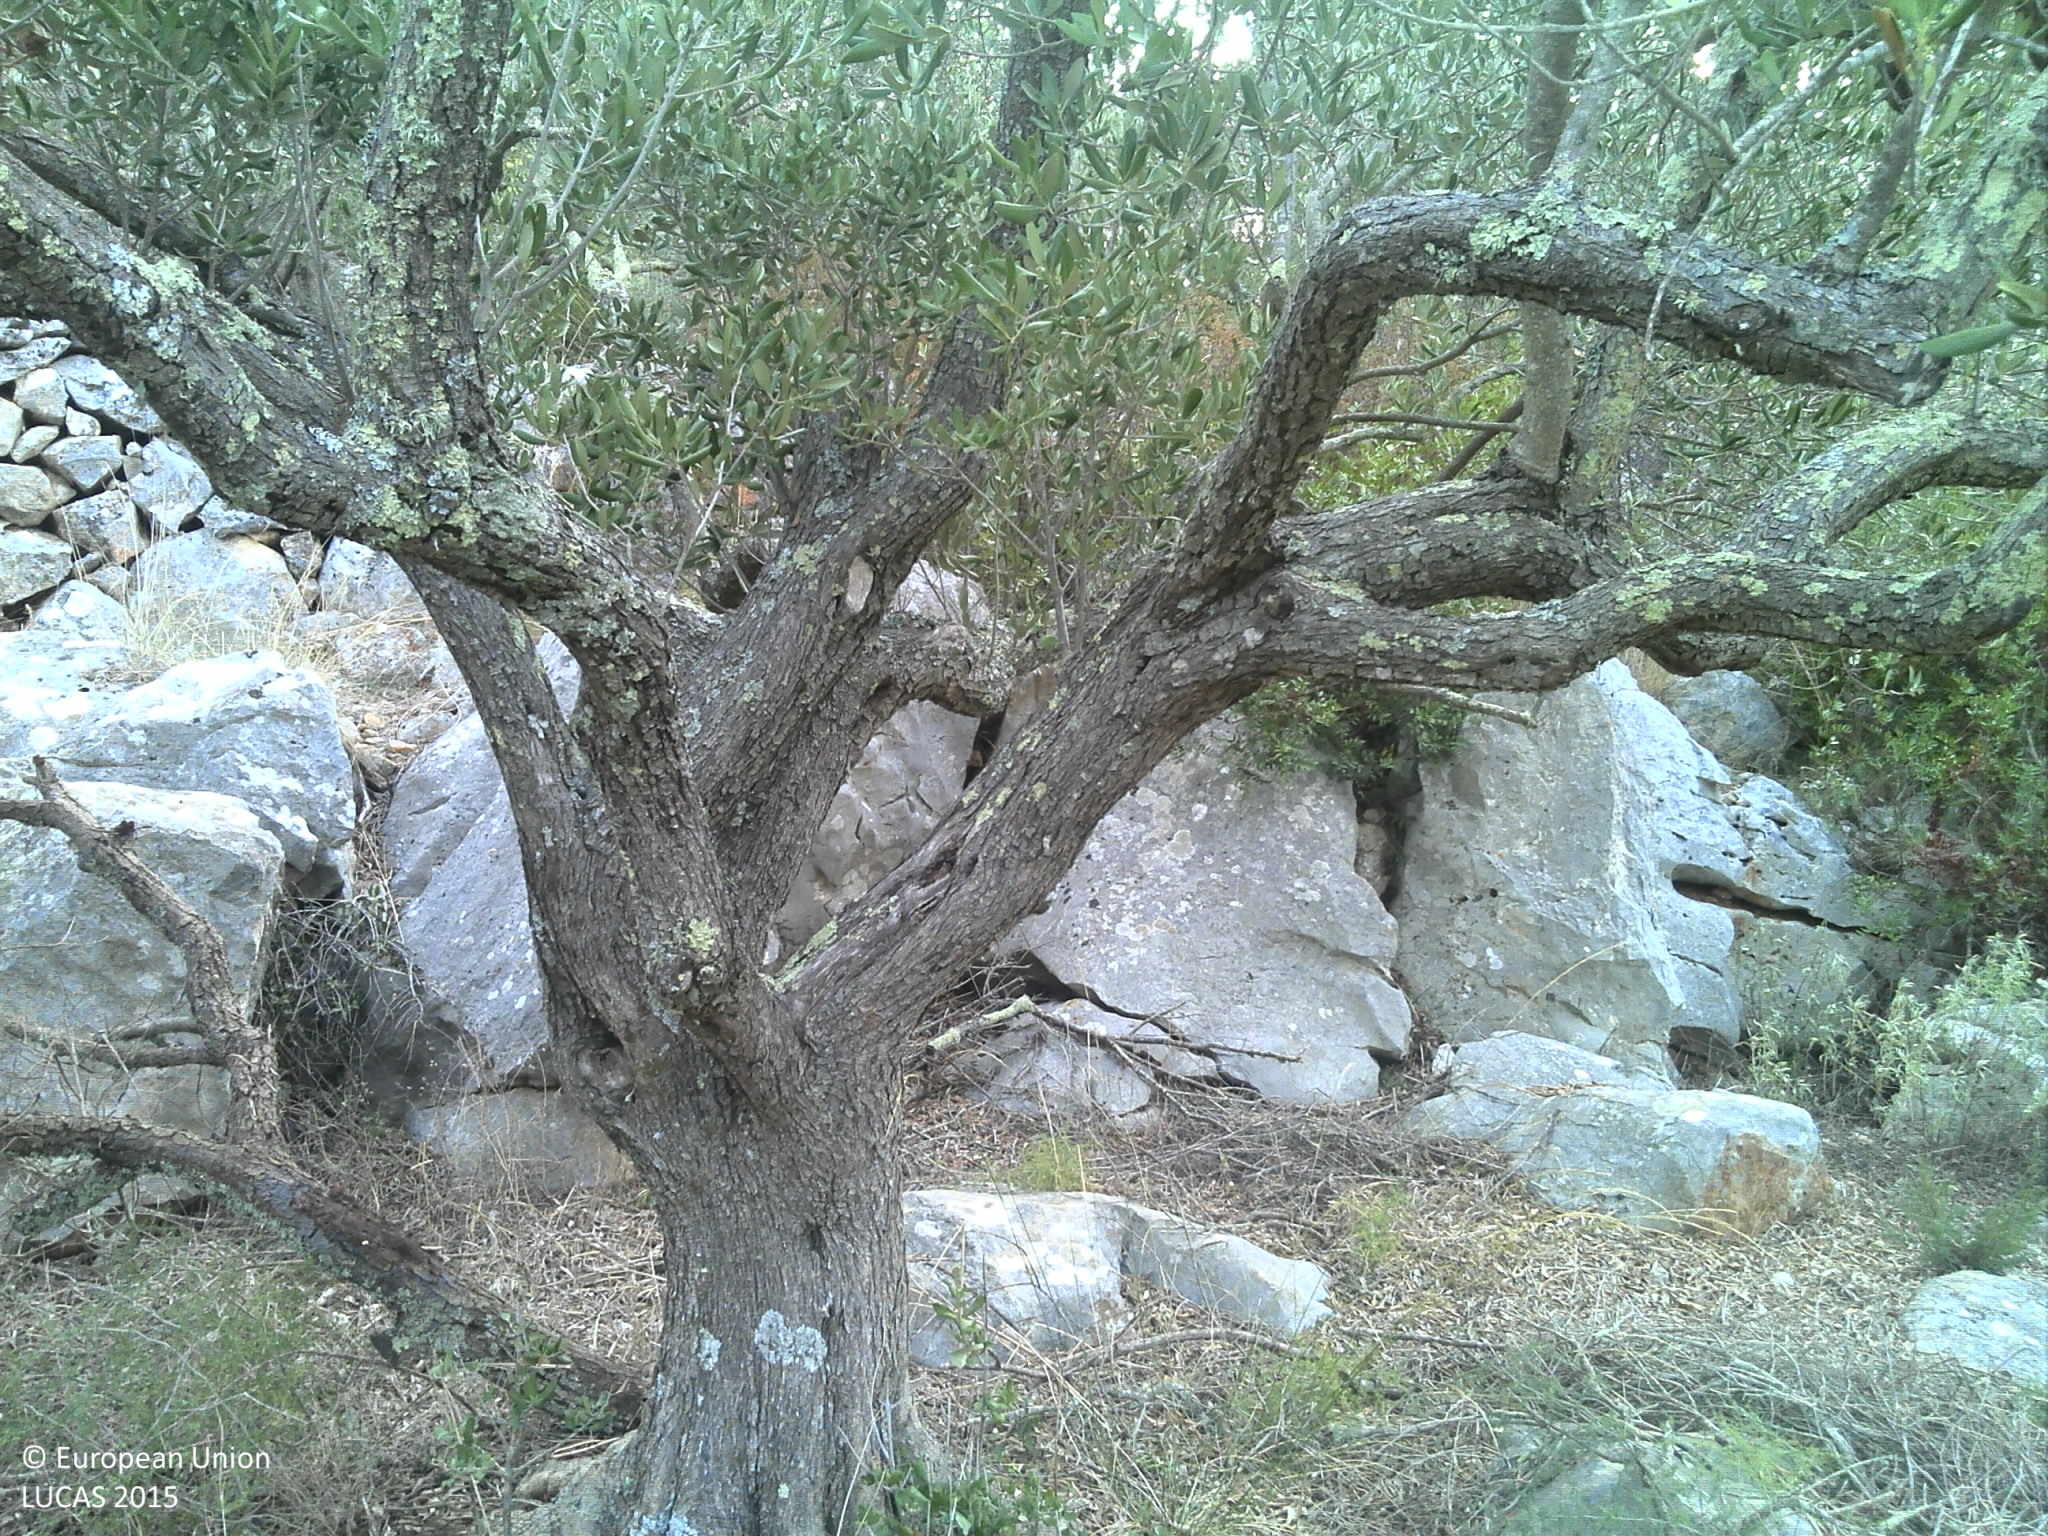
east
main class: Cropland
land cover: Olive groves
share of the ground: 25 - 50 %
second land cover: Rocks and stones
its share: > 75 %
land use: Agriculture (excluding fallow land and kitchen gardens)
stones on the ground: < 10 %
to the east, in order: Olive groves; Rocks and stones; Dry stone walls; Olive groves; Dry stone walls; Olive groves; Dry stone walls; Olive groves; Dry stone walls; Olive groves; Dry stone walls; Olive groves; Dry stone walls; Olive groves; Dry stone walls; Tracks; Shrubland with sparse tree cover; Tracks; Shrubland with sparse tree cover; Olive groves; Dry stone walls; Olive groves; Dry stone walls; Olive groves; Dry stone walls; Olive groves; Dry stone walls; Olive groves; Dry stone walls; Shrubland with sparse tree cover; Dry stone walls; Olive groves
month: September
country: HR
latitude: 43.9535
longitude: 15.1130
